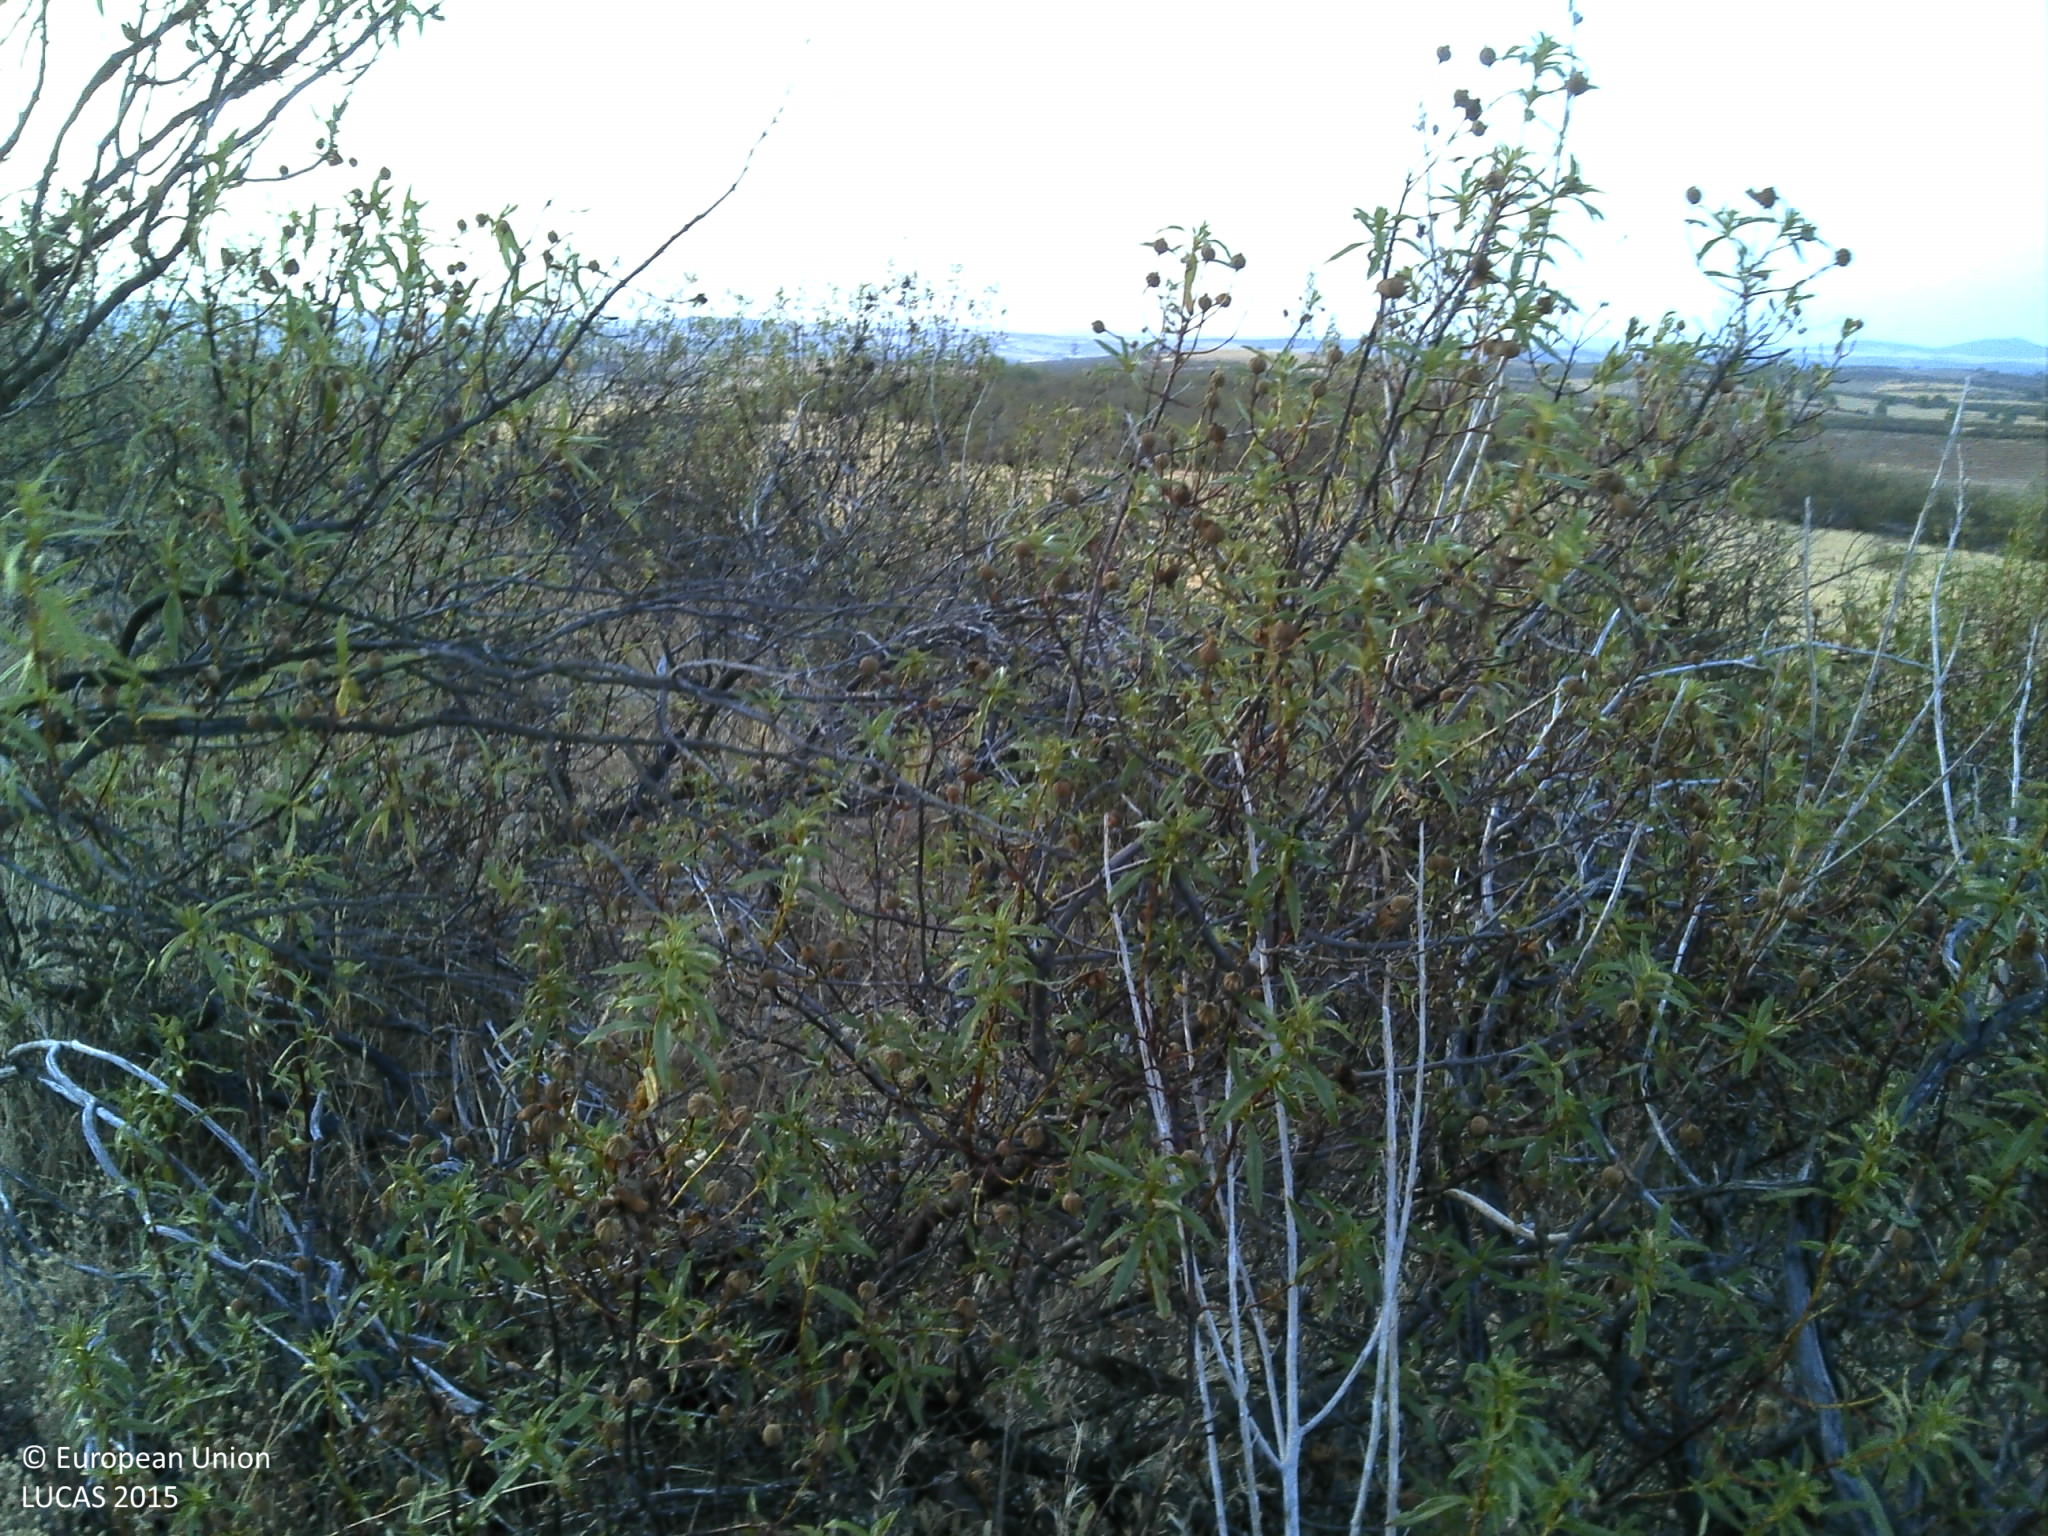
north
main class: Shrubland
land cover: Shrubland without tree cover
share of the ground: 50 - 75 %
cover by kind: shrubs 70 %, herbaceous plants 20 %, unconsolidated bare surface 10 %
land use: Abandoned areas
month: July
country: PT
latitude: 37.5751
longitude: -7.8753
